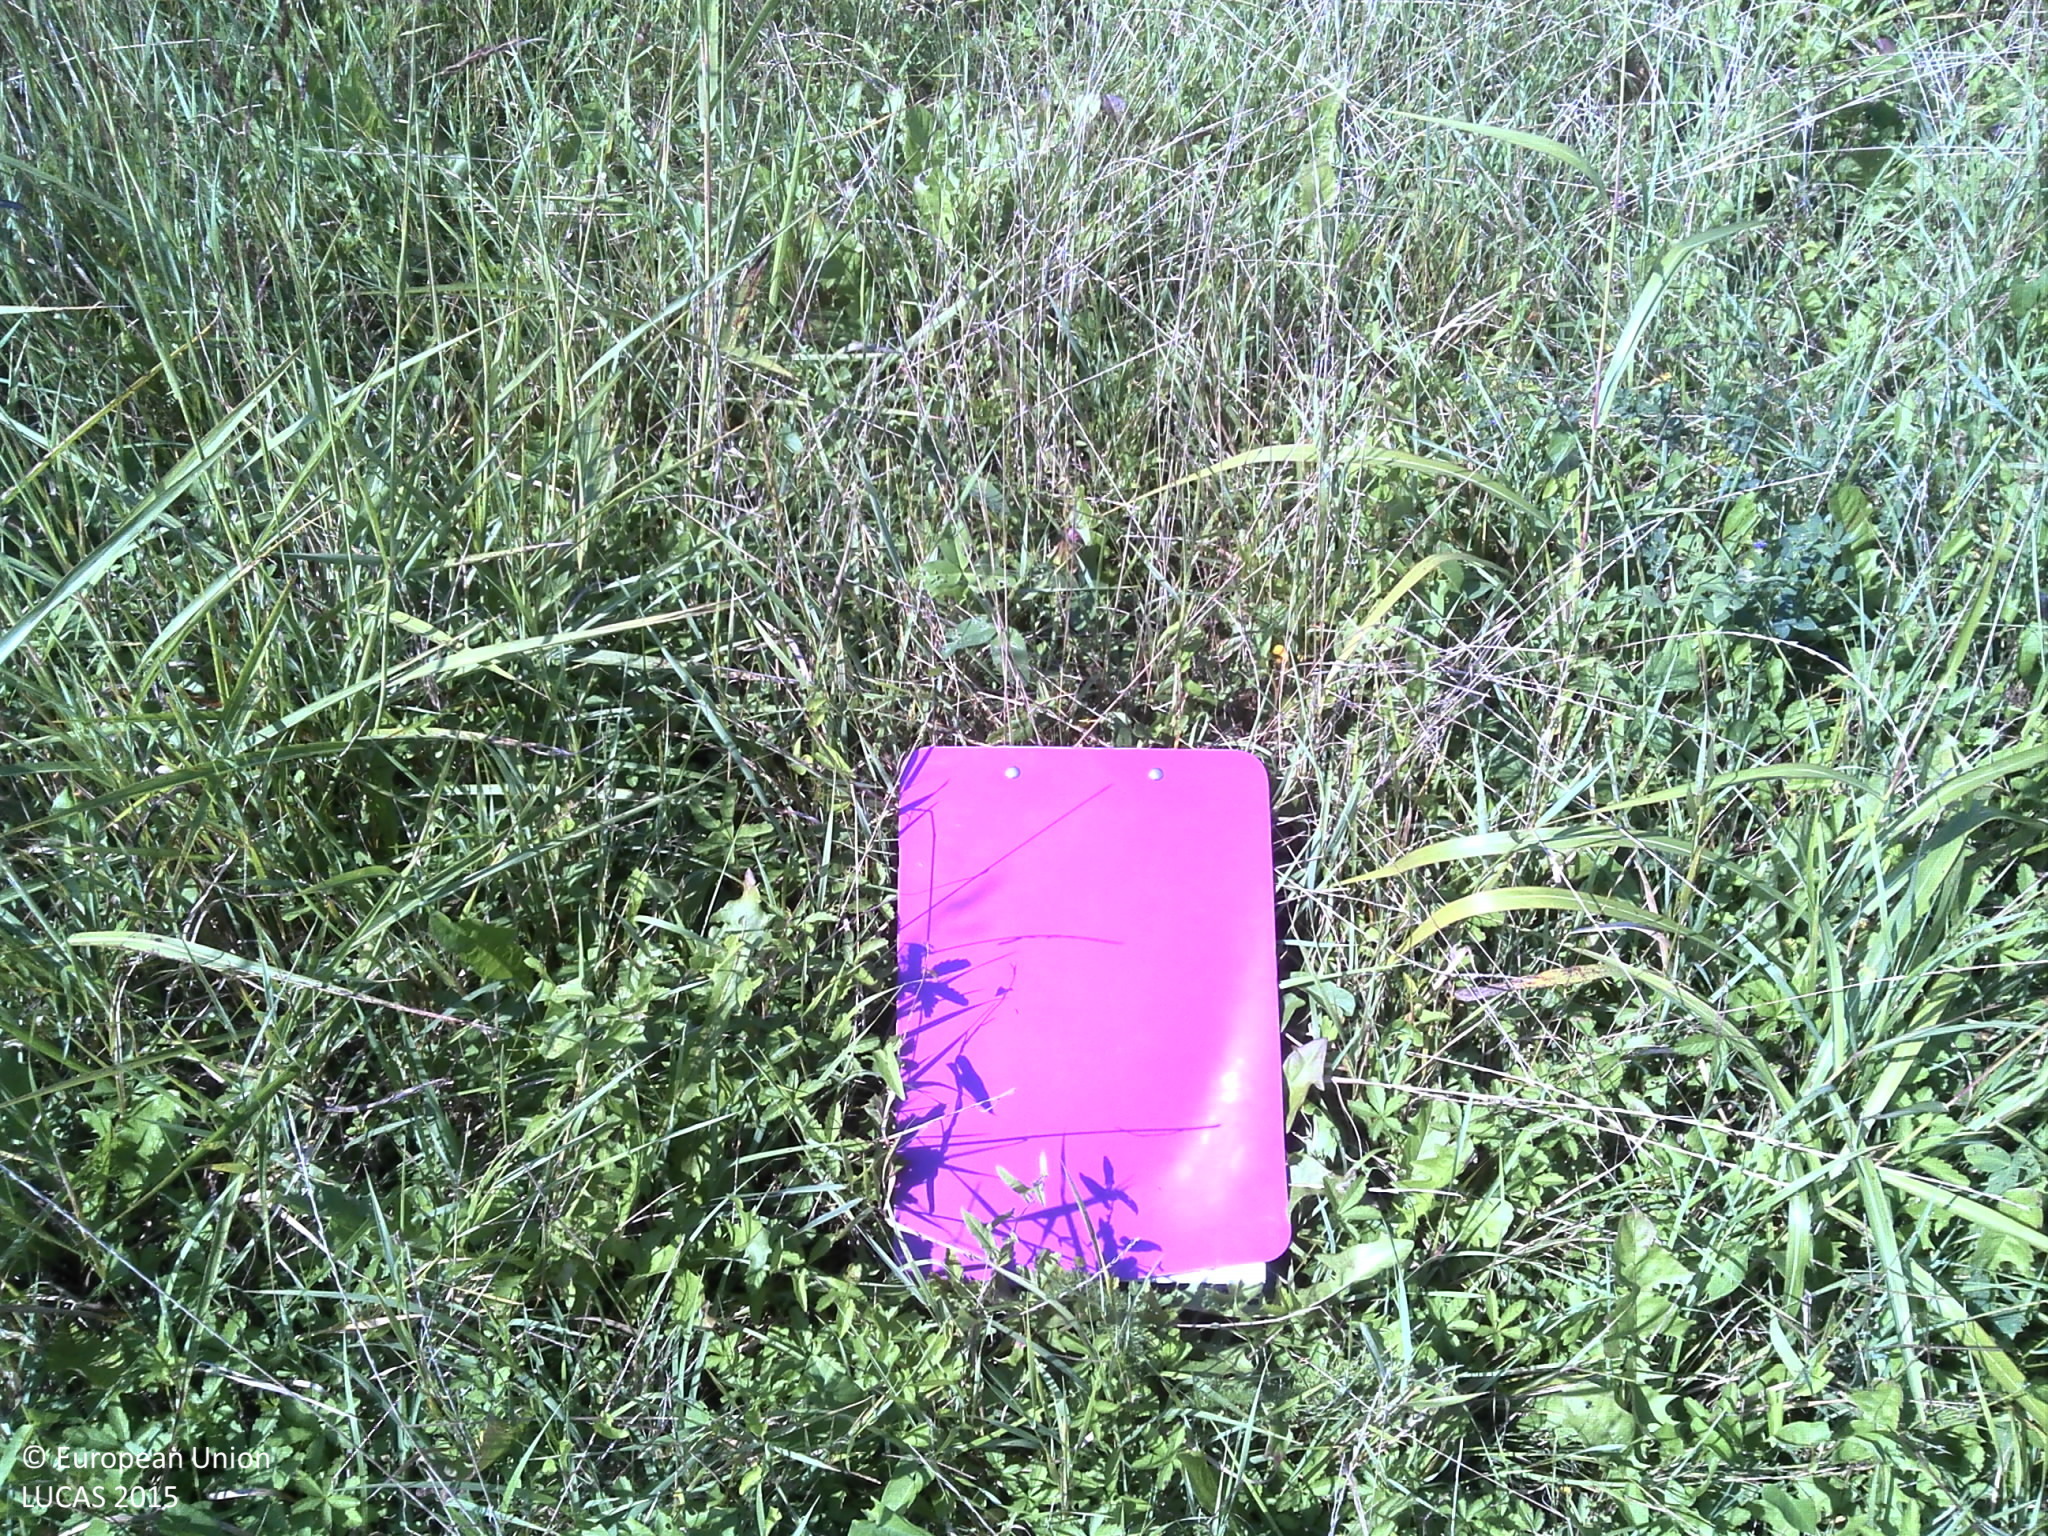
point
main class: Grassland
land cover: Grassland without tree/shrub cover
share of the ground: > 75 %
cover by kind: herbaceous plants 100 %
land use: Semi-natural and natural areas not in use
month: September
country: HR
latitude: 45.6401
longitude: 16.3231
